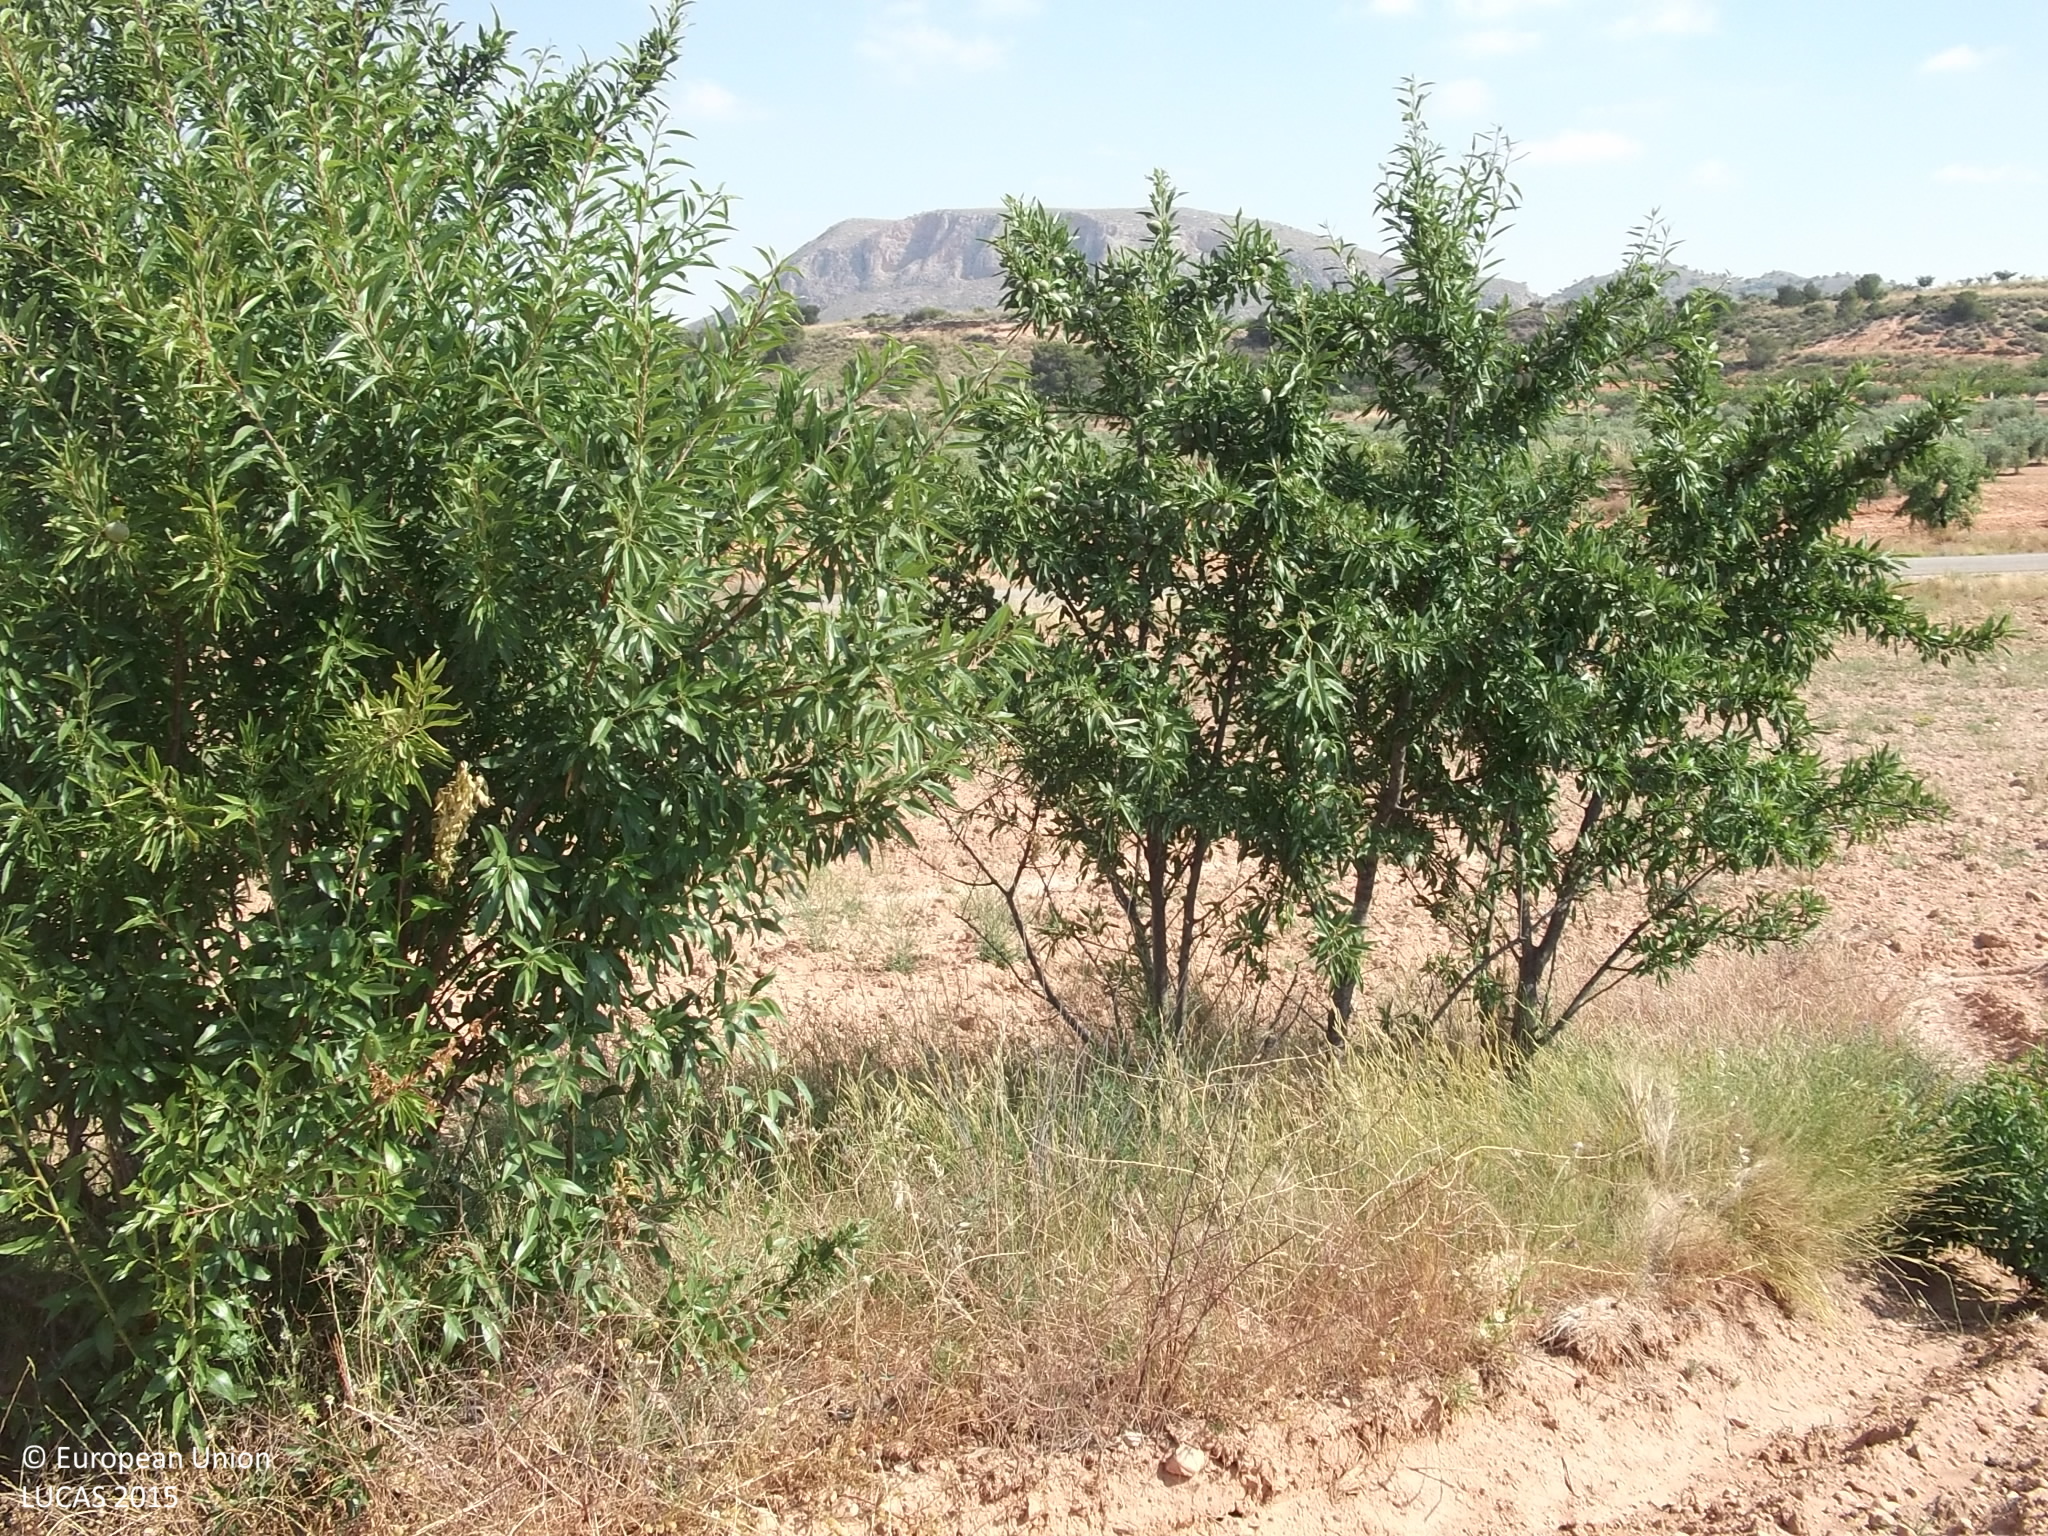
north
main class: Grassland
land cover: Spontaneously vegetated surfaces
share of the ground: 25 - 50 %
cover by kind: unconsolidated bare surface 75 %, herbaceous plants 25 %
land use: Fallow land
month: May
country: ES
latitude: 38.4604
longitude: -1.4629
